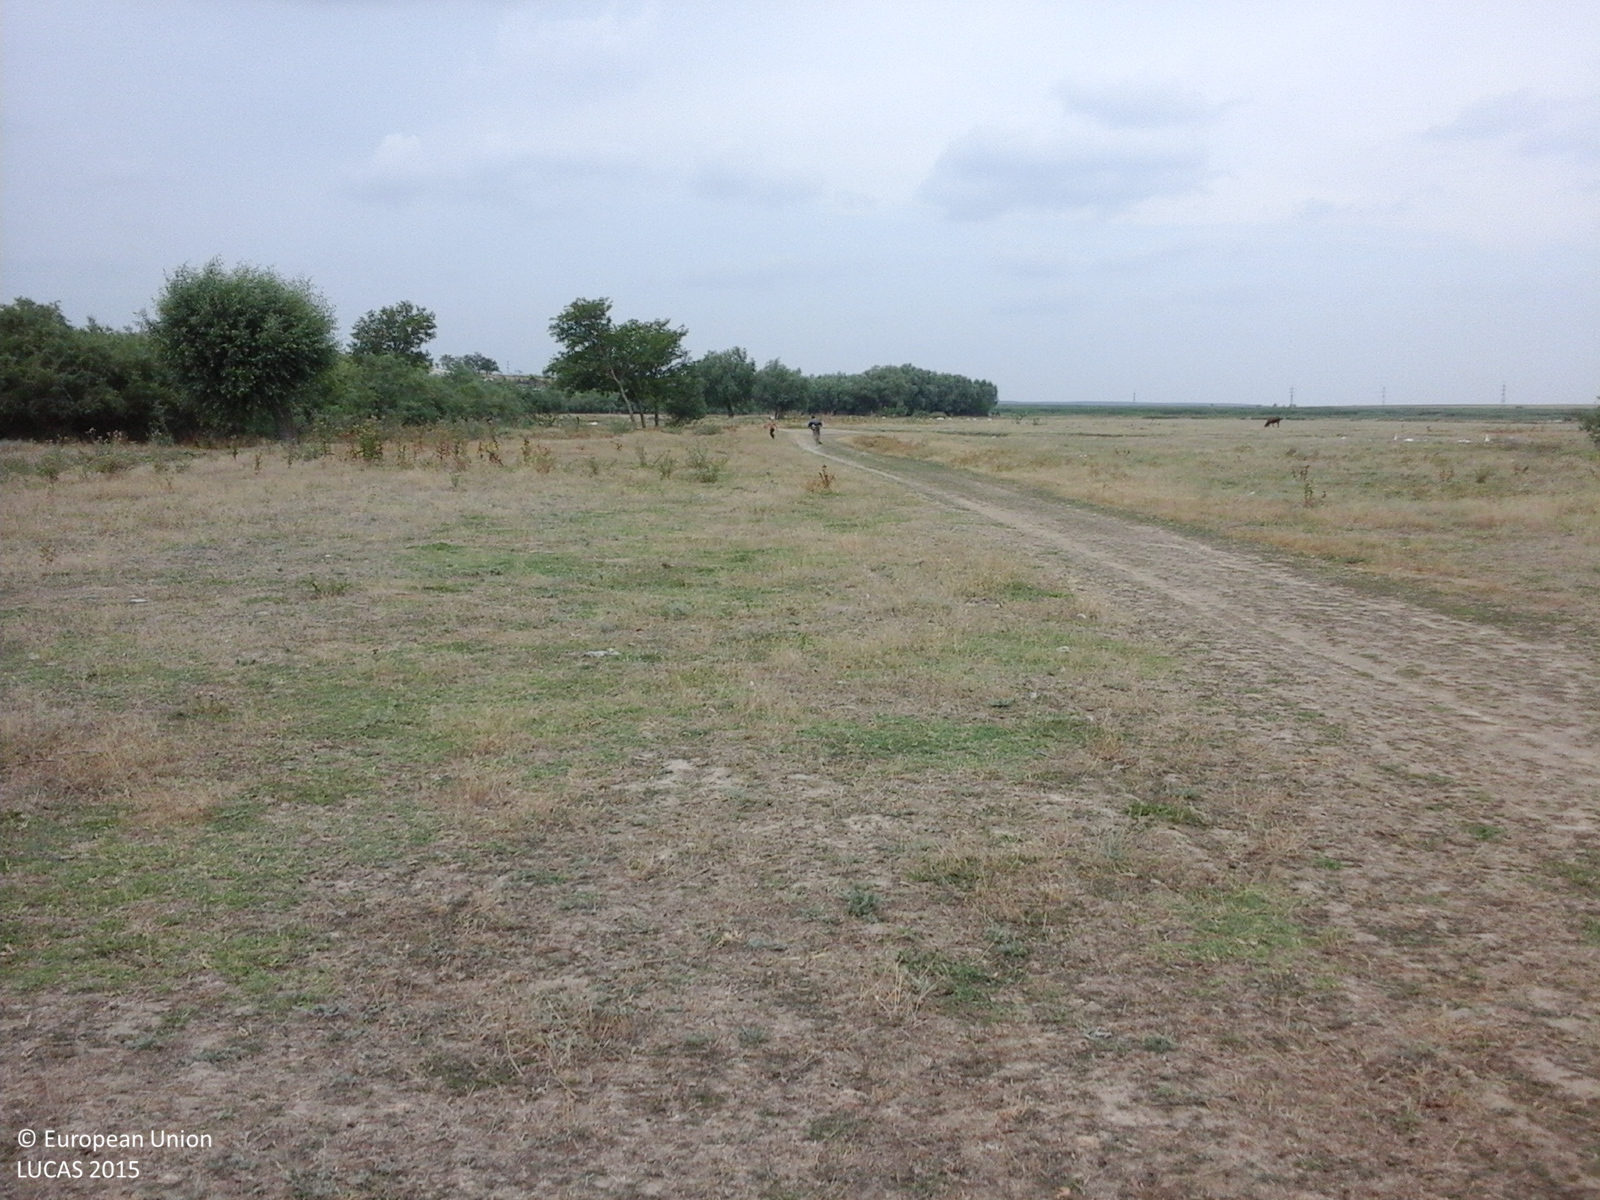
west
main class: Grassland
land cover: Spontaneously vegetated surfaces
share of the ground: > 75 %
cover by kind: herbaceous plants 100 %
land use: Semi-natural and natural areas not in use
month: July
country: RO
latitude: 45.0253
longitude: 28.2311
